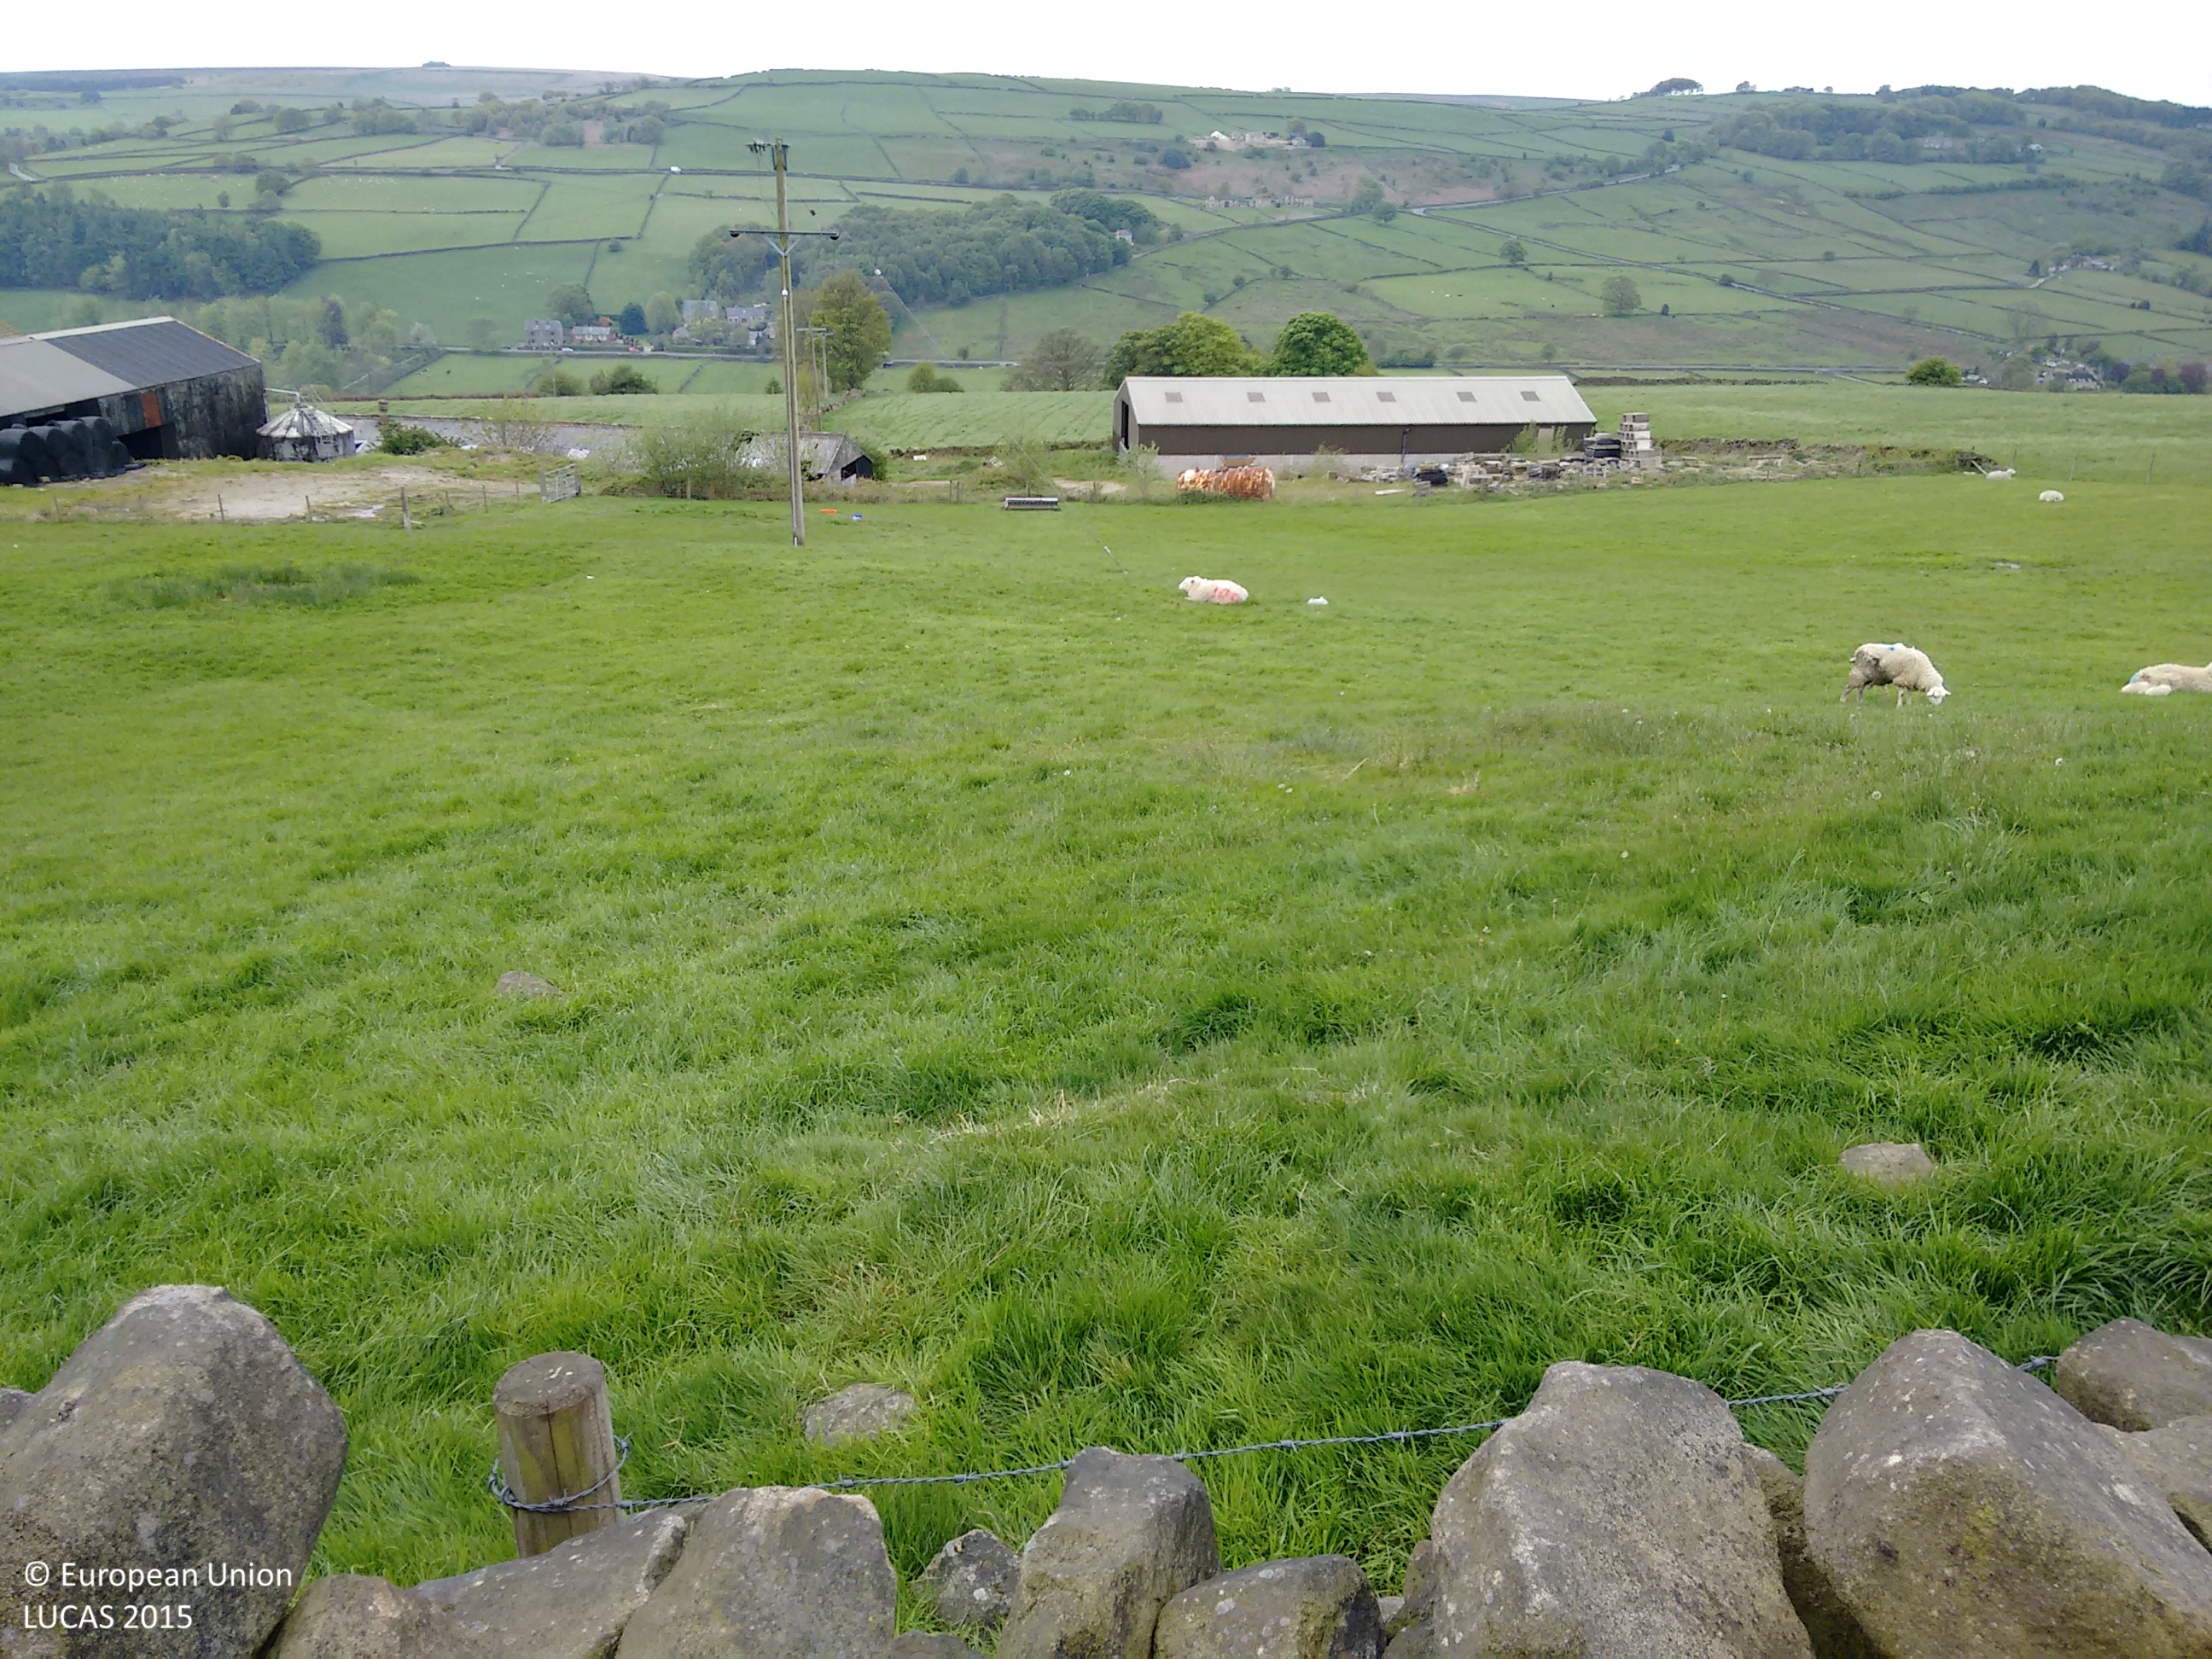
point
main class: Grassland
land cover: Grassland without tree/shrub cover
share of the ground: > 75 %
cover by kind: herbaceous plants 100 %
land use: Agriculture (excluding fallow land and kitchen gardens)
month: May
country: GB
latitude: 53.4243
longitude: -1.5938
